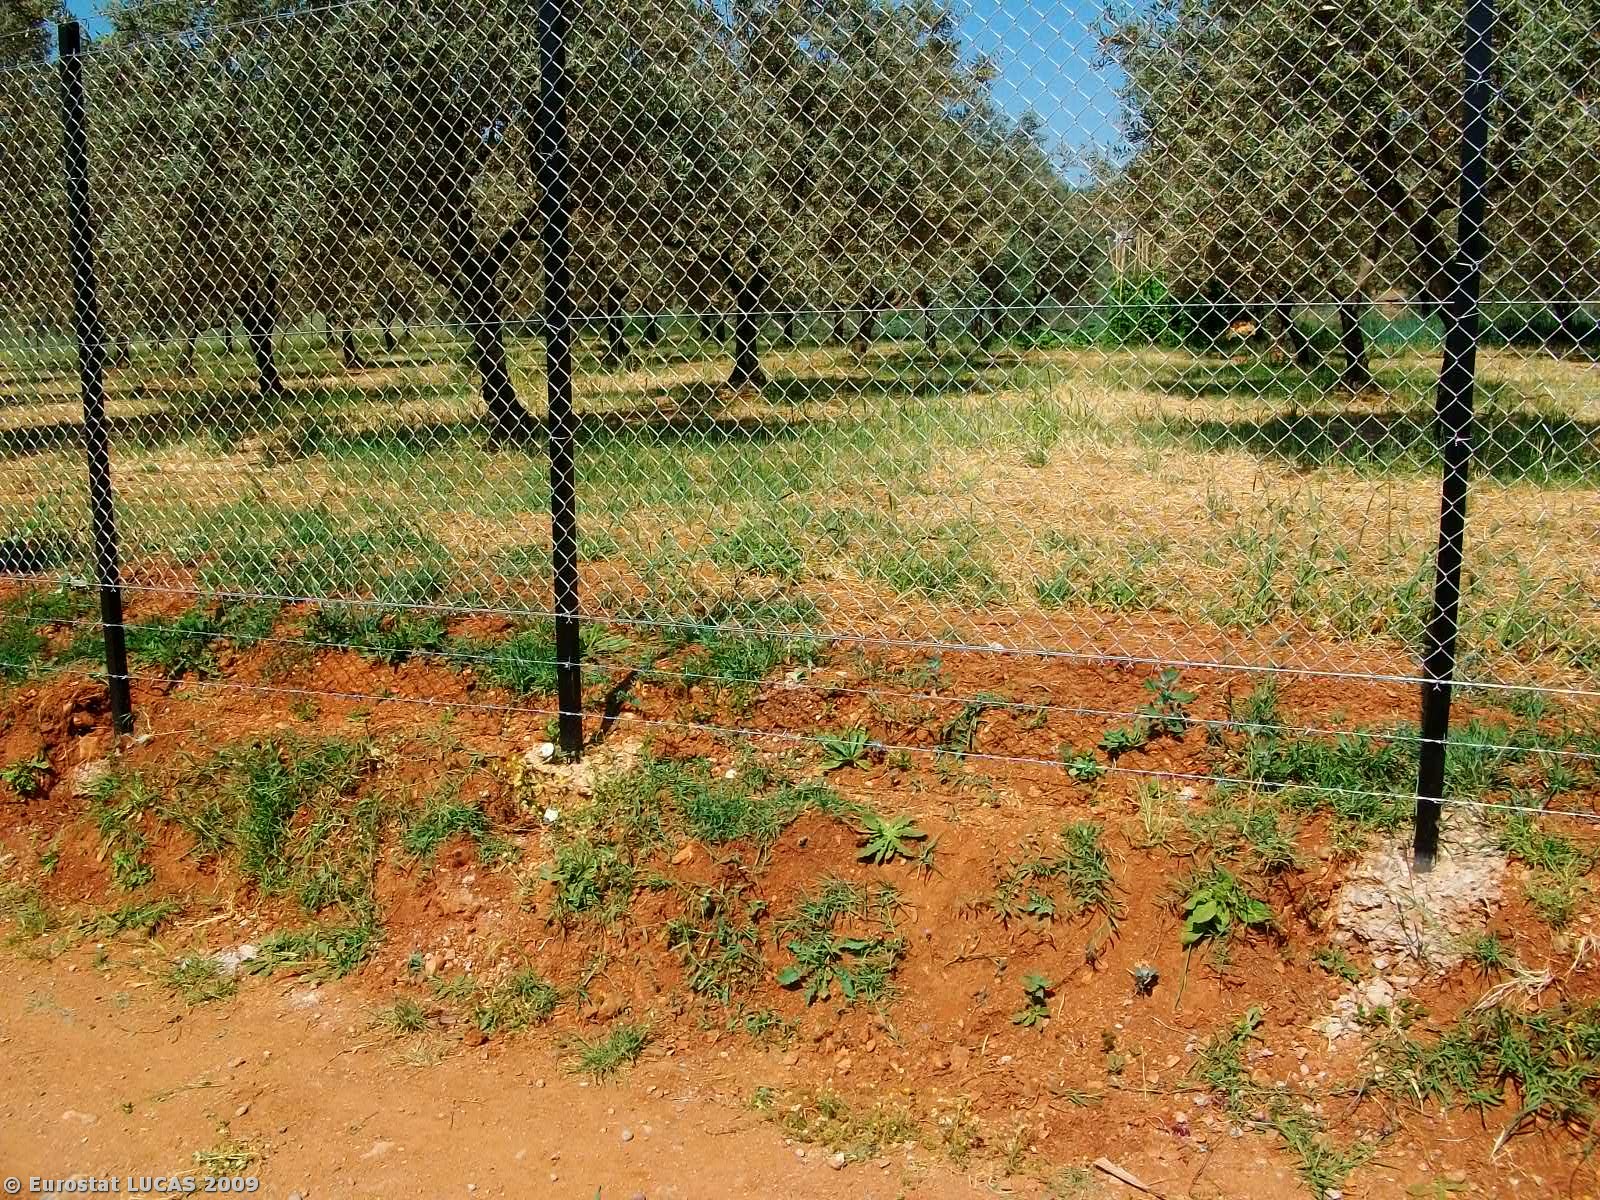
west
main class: Cropland
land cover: Olive groves
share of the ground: 50 - 75 %
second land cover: Grassland with sparse tree/shrub cover
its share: 50 - 75 %
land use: Agriculture (excluding fallow land and kitchen gardens)
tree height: < 5 m
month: May
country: GR
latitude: 38.6270
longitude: 21.4454
